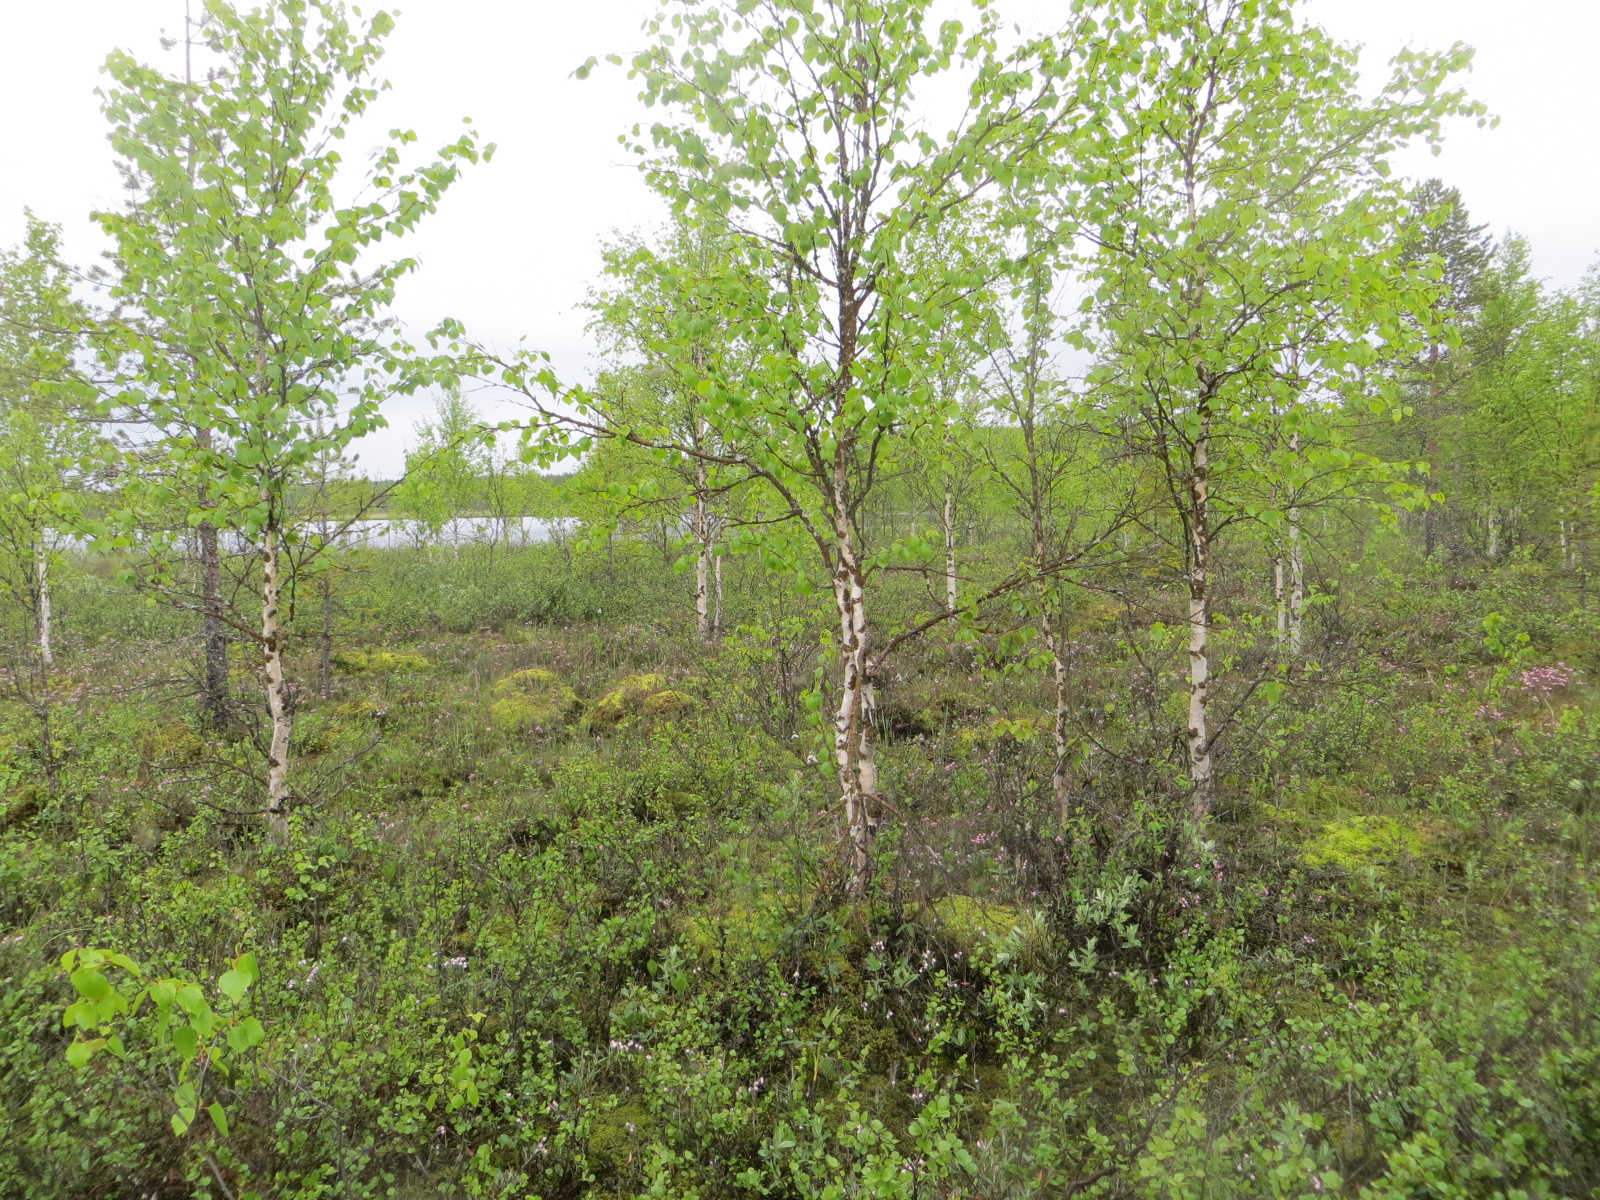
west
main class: Woodland
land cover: Broadleaved woodland
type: mire and swamp forests
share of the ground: 50 - 75 %
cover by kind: broadleaved forest trees 50 %, shrubs 40 %, coniferous forest trees 10 %
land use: Forestry
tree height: > 5 m
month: June
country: FI
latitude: 66.6358
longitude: 24.8041
